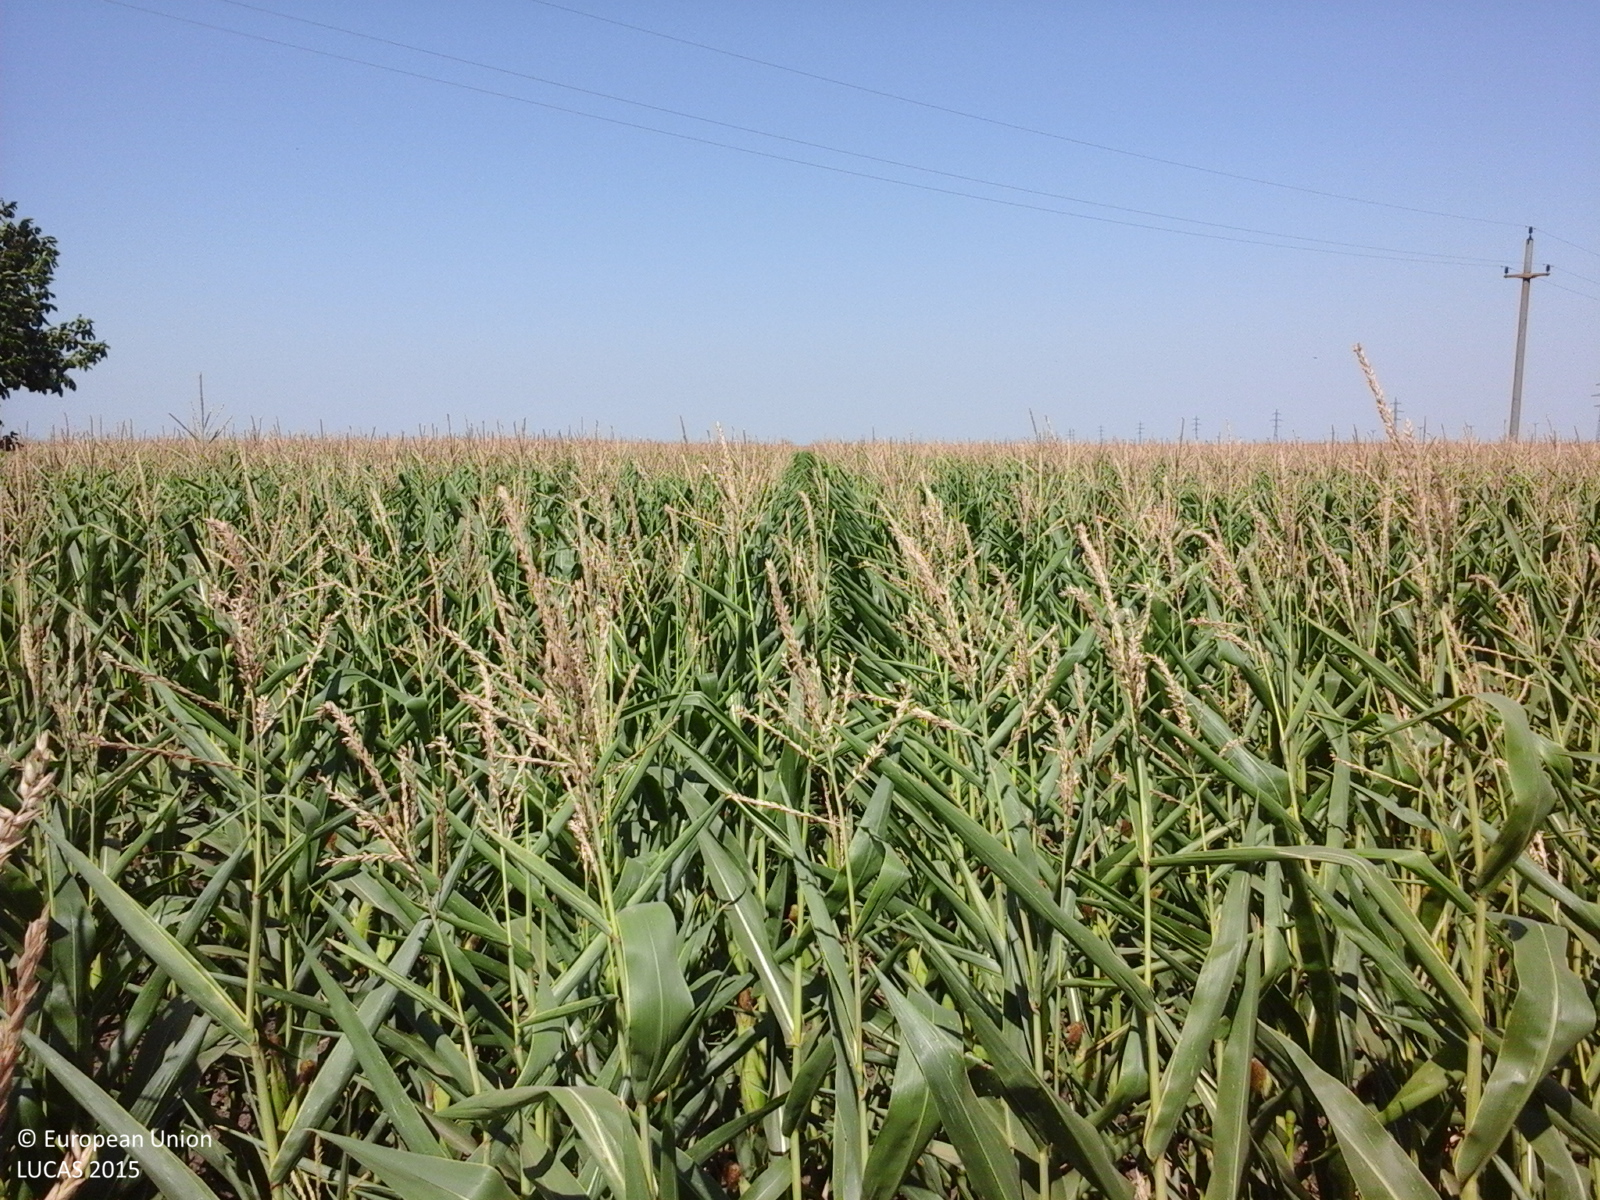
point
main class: Cropland
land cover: Maize
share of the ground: > 75 %
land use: Agriculture (excluding fallow land and kitchen gardens)
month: July
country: RO
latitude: 44.3439
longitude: 26.7147
